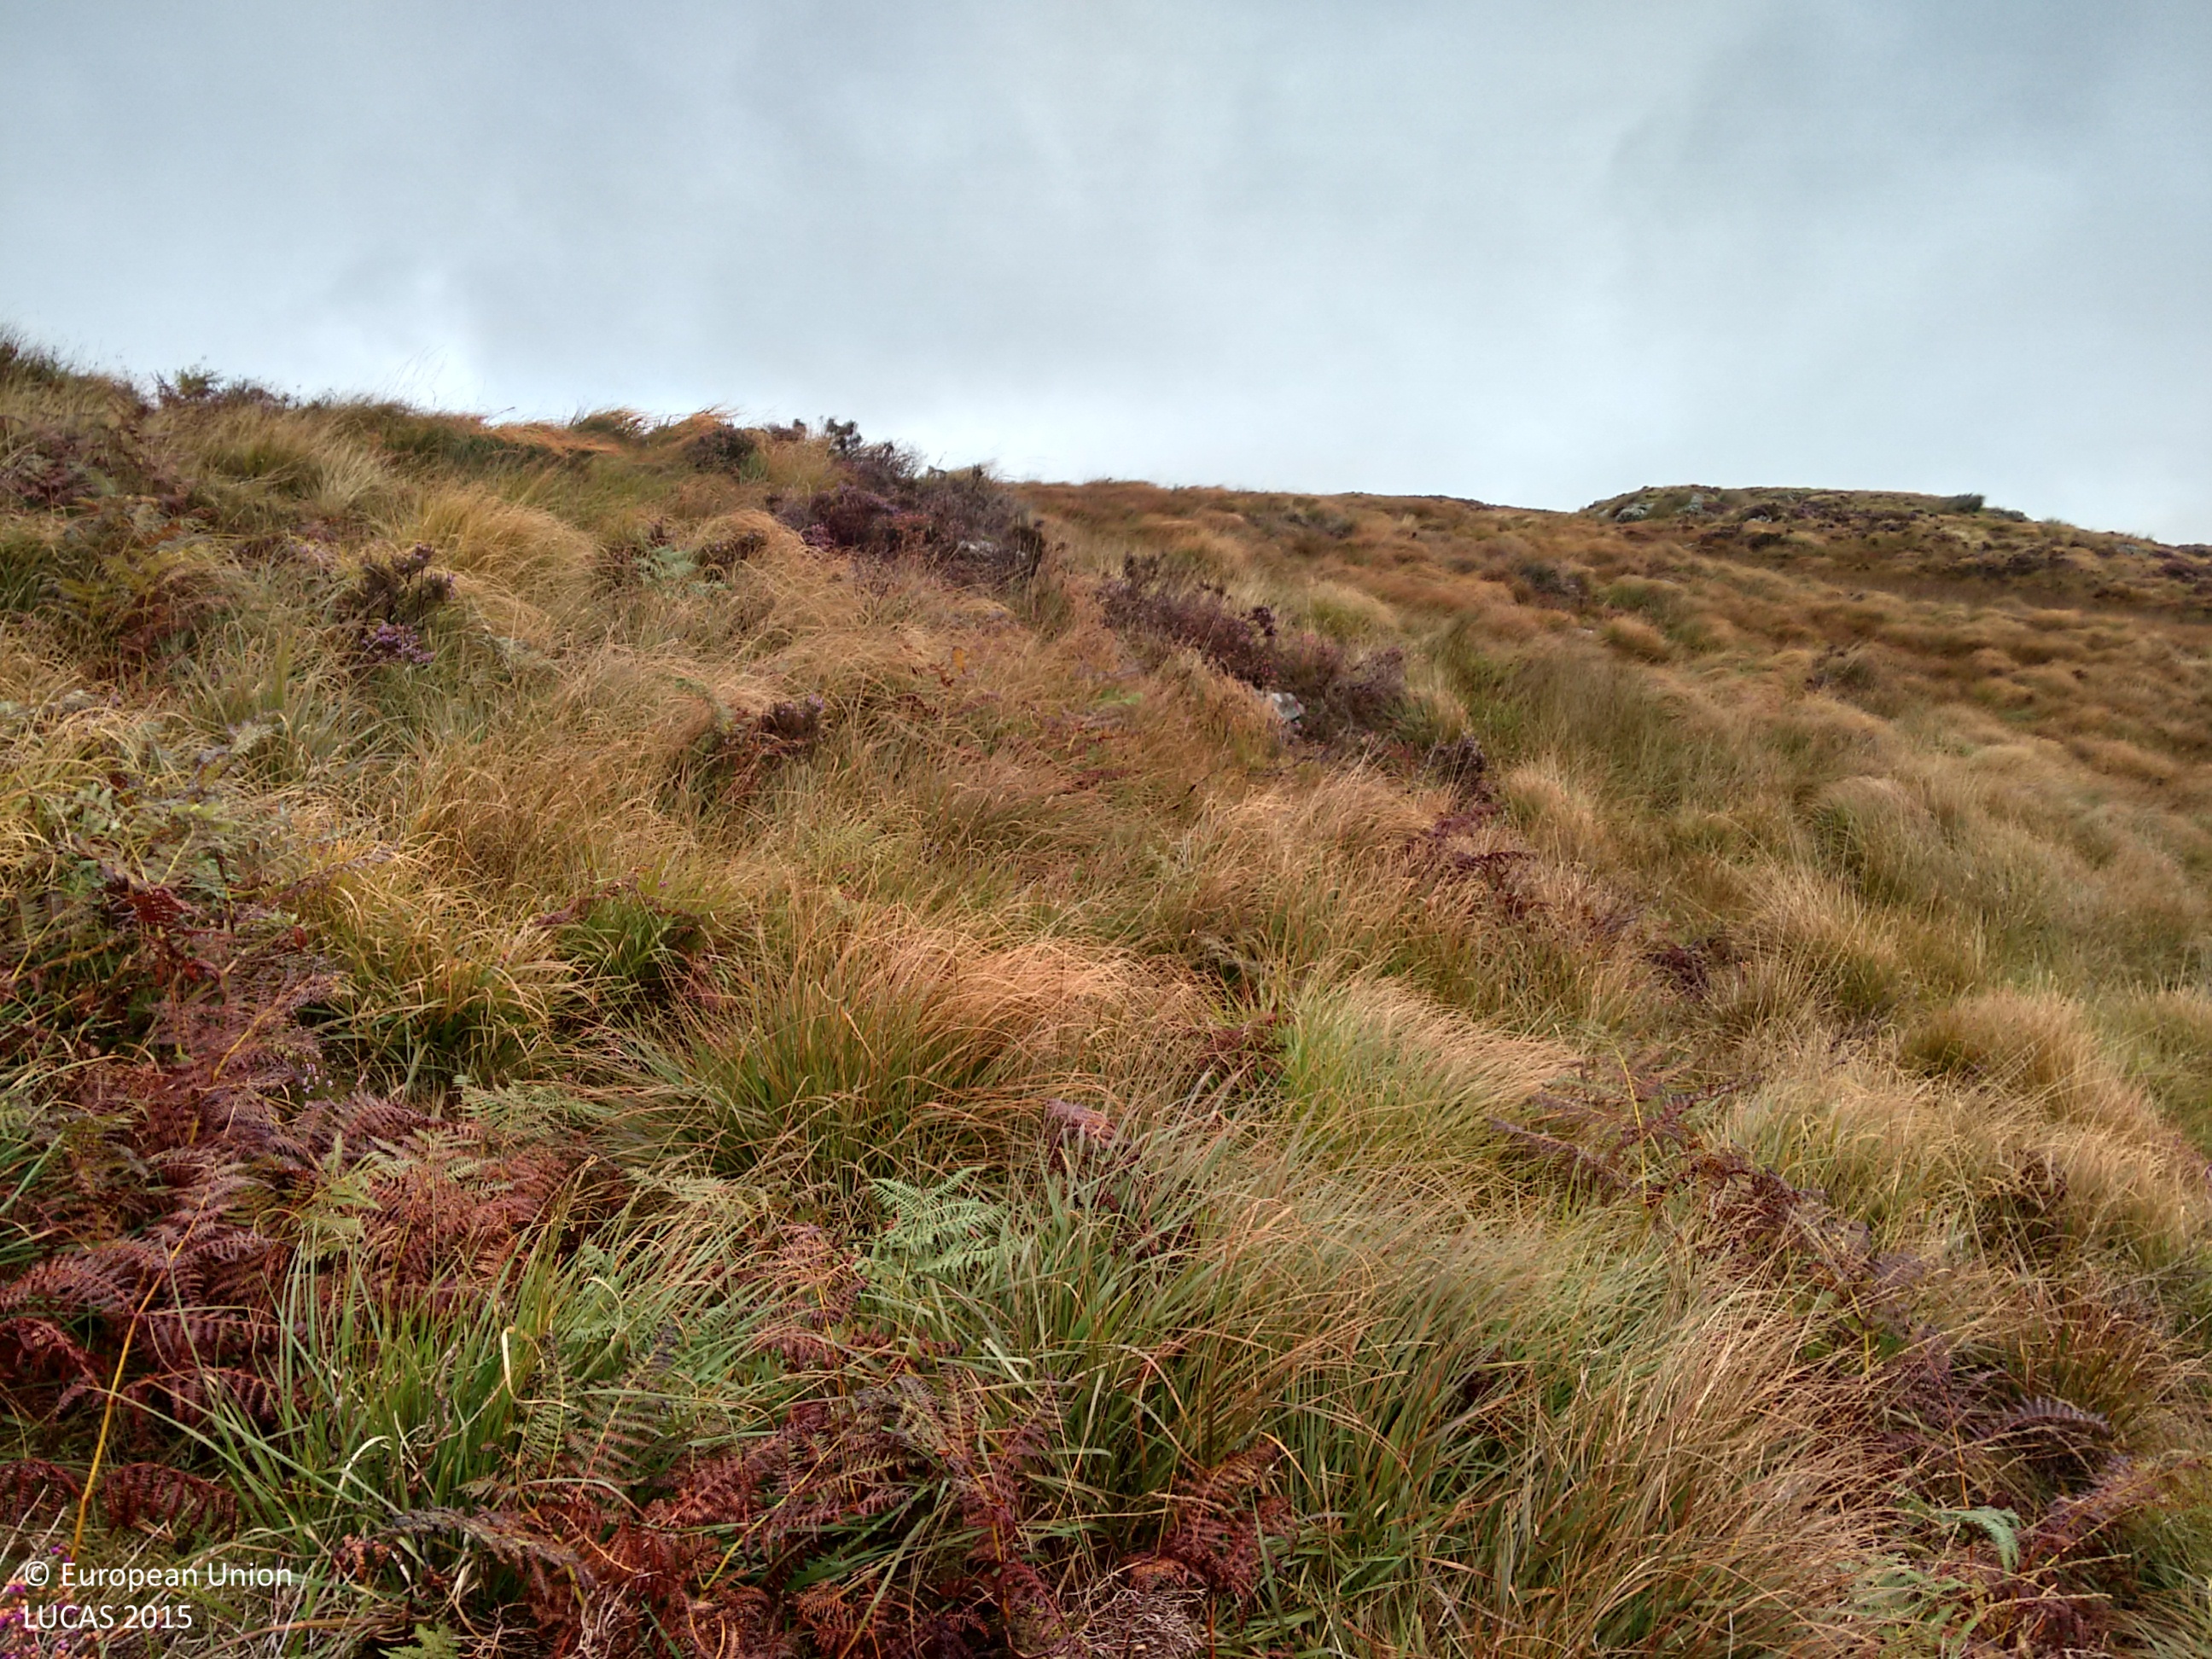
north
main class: Shrubland
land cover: Shrubland without tree cover
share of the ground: > 75 %
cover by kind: herbaceous plants 70 %, shrubs 30 %
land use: Agriculture (excluding fallow land and kitchen gardens)
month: September
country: GB
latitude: 55.7416
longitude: -5.4289
